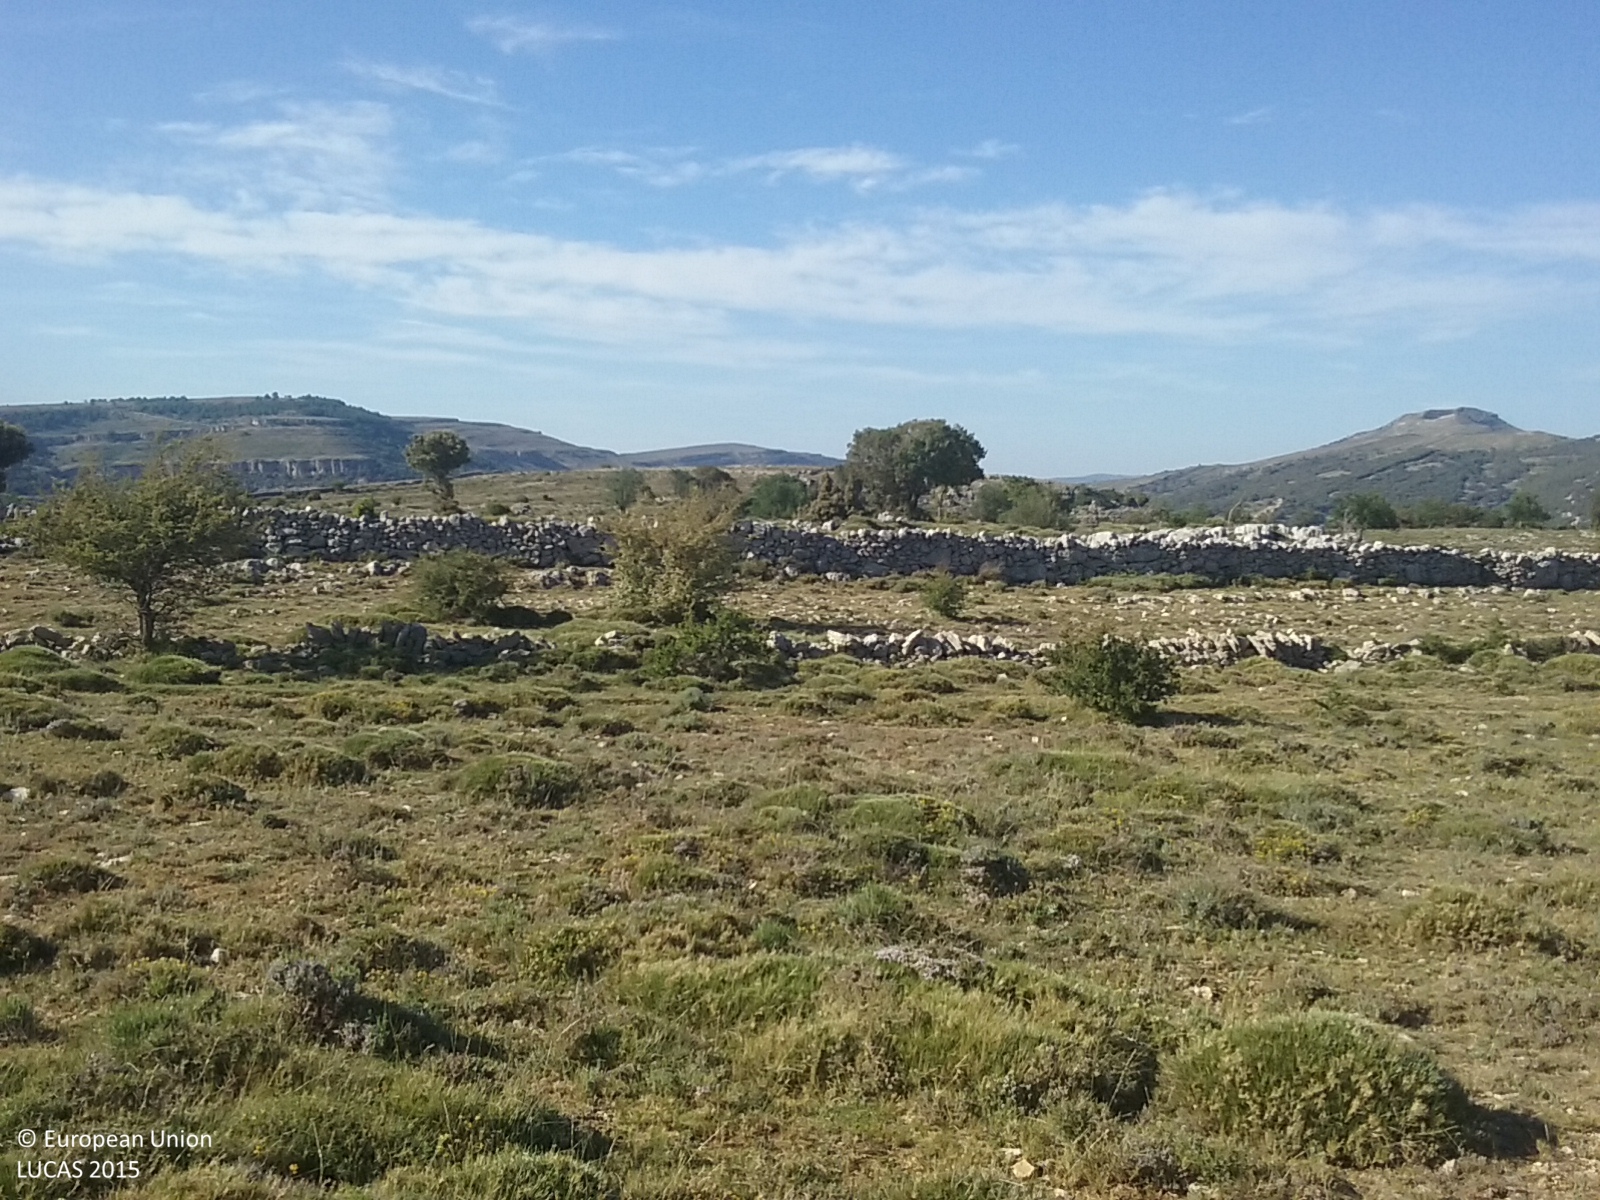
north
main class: Shrubland
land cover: Shrubland without tree cover
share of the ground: > 75 %
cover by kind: herbaceous plants 60 %, shrubs 30 %
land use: Agriculture (excluding fallow land and kitchen gardens)
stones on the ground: 25 - 50 %
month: May
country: ES
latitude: 40.4231
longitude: -0.0590
